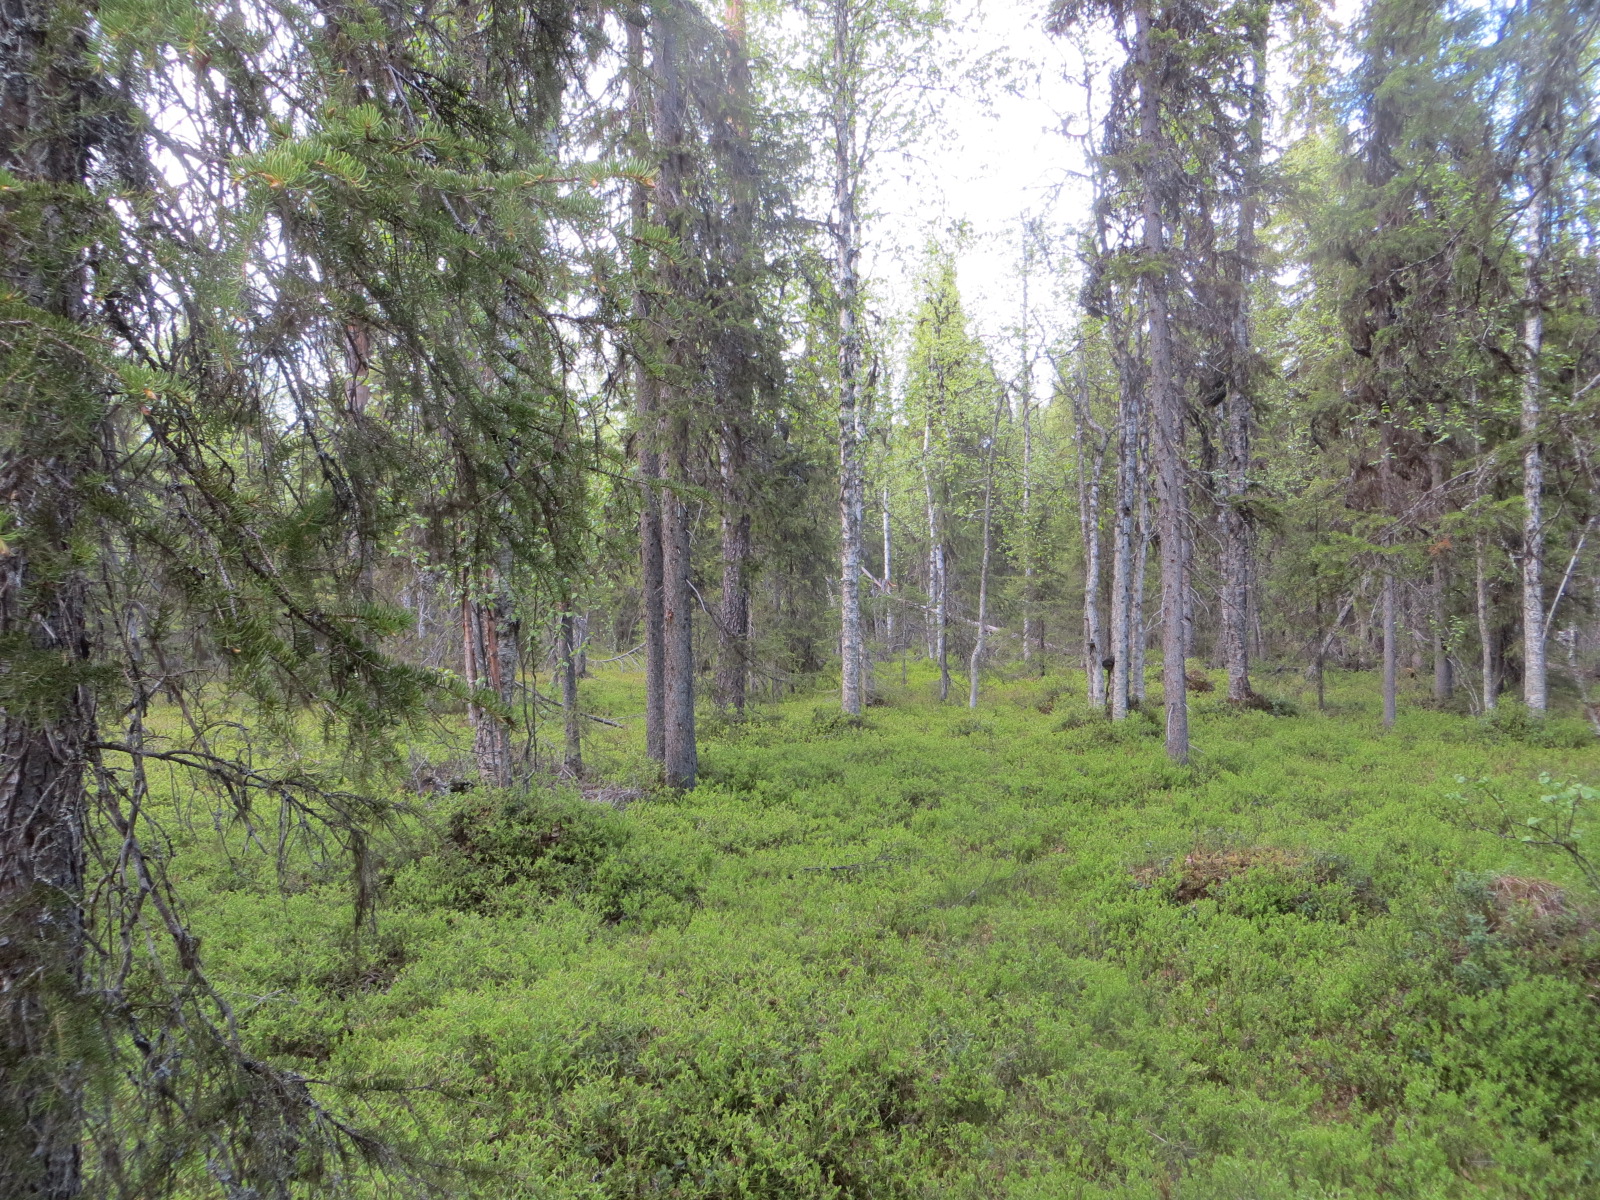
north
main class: Woodland
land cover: Spruce dominated mixed woodland
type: boreal forest
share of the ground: 50 - 75 %
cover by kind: coniferous forest trees 60 %, broadleaved forest trees 20 %, shrubs 20 %
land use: Forestry
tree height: > 5 m
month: June
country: FI
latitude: 67.4881
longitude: 25.8548
